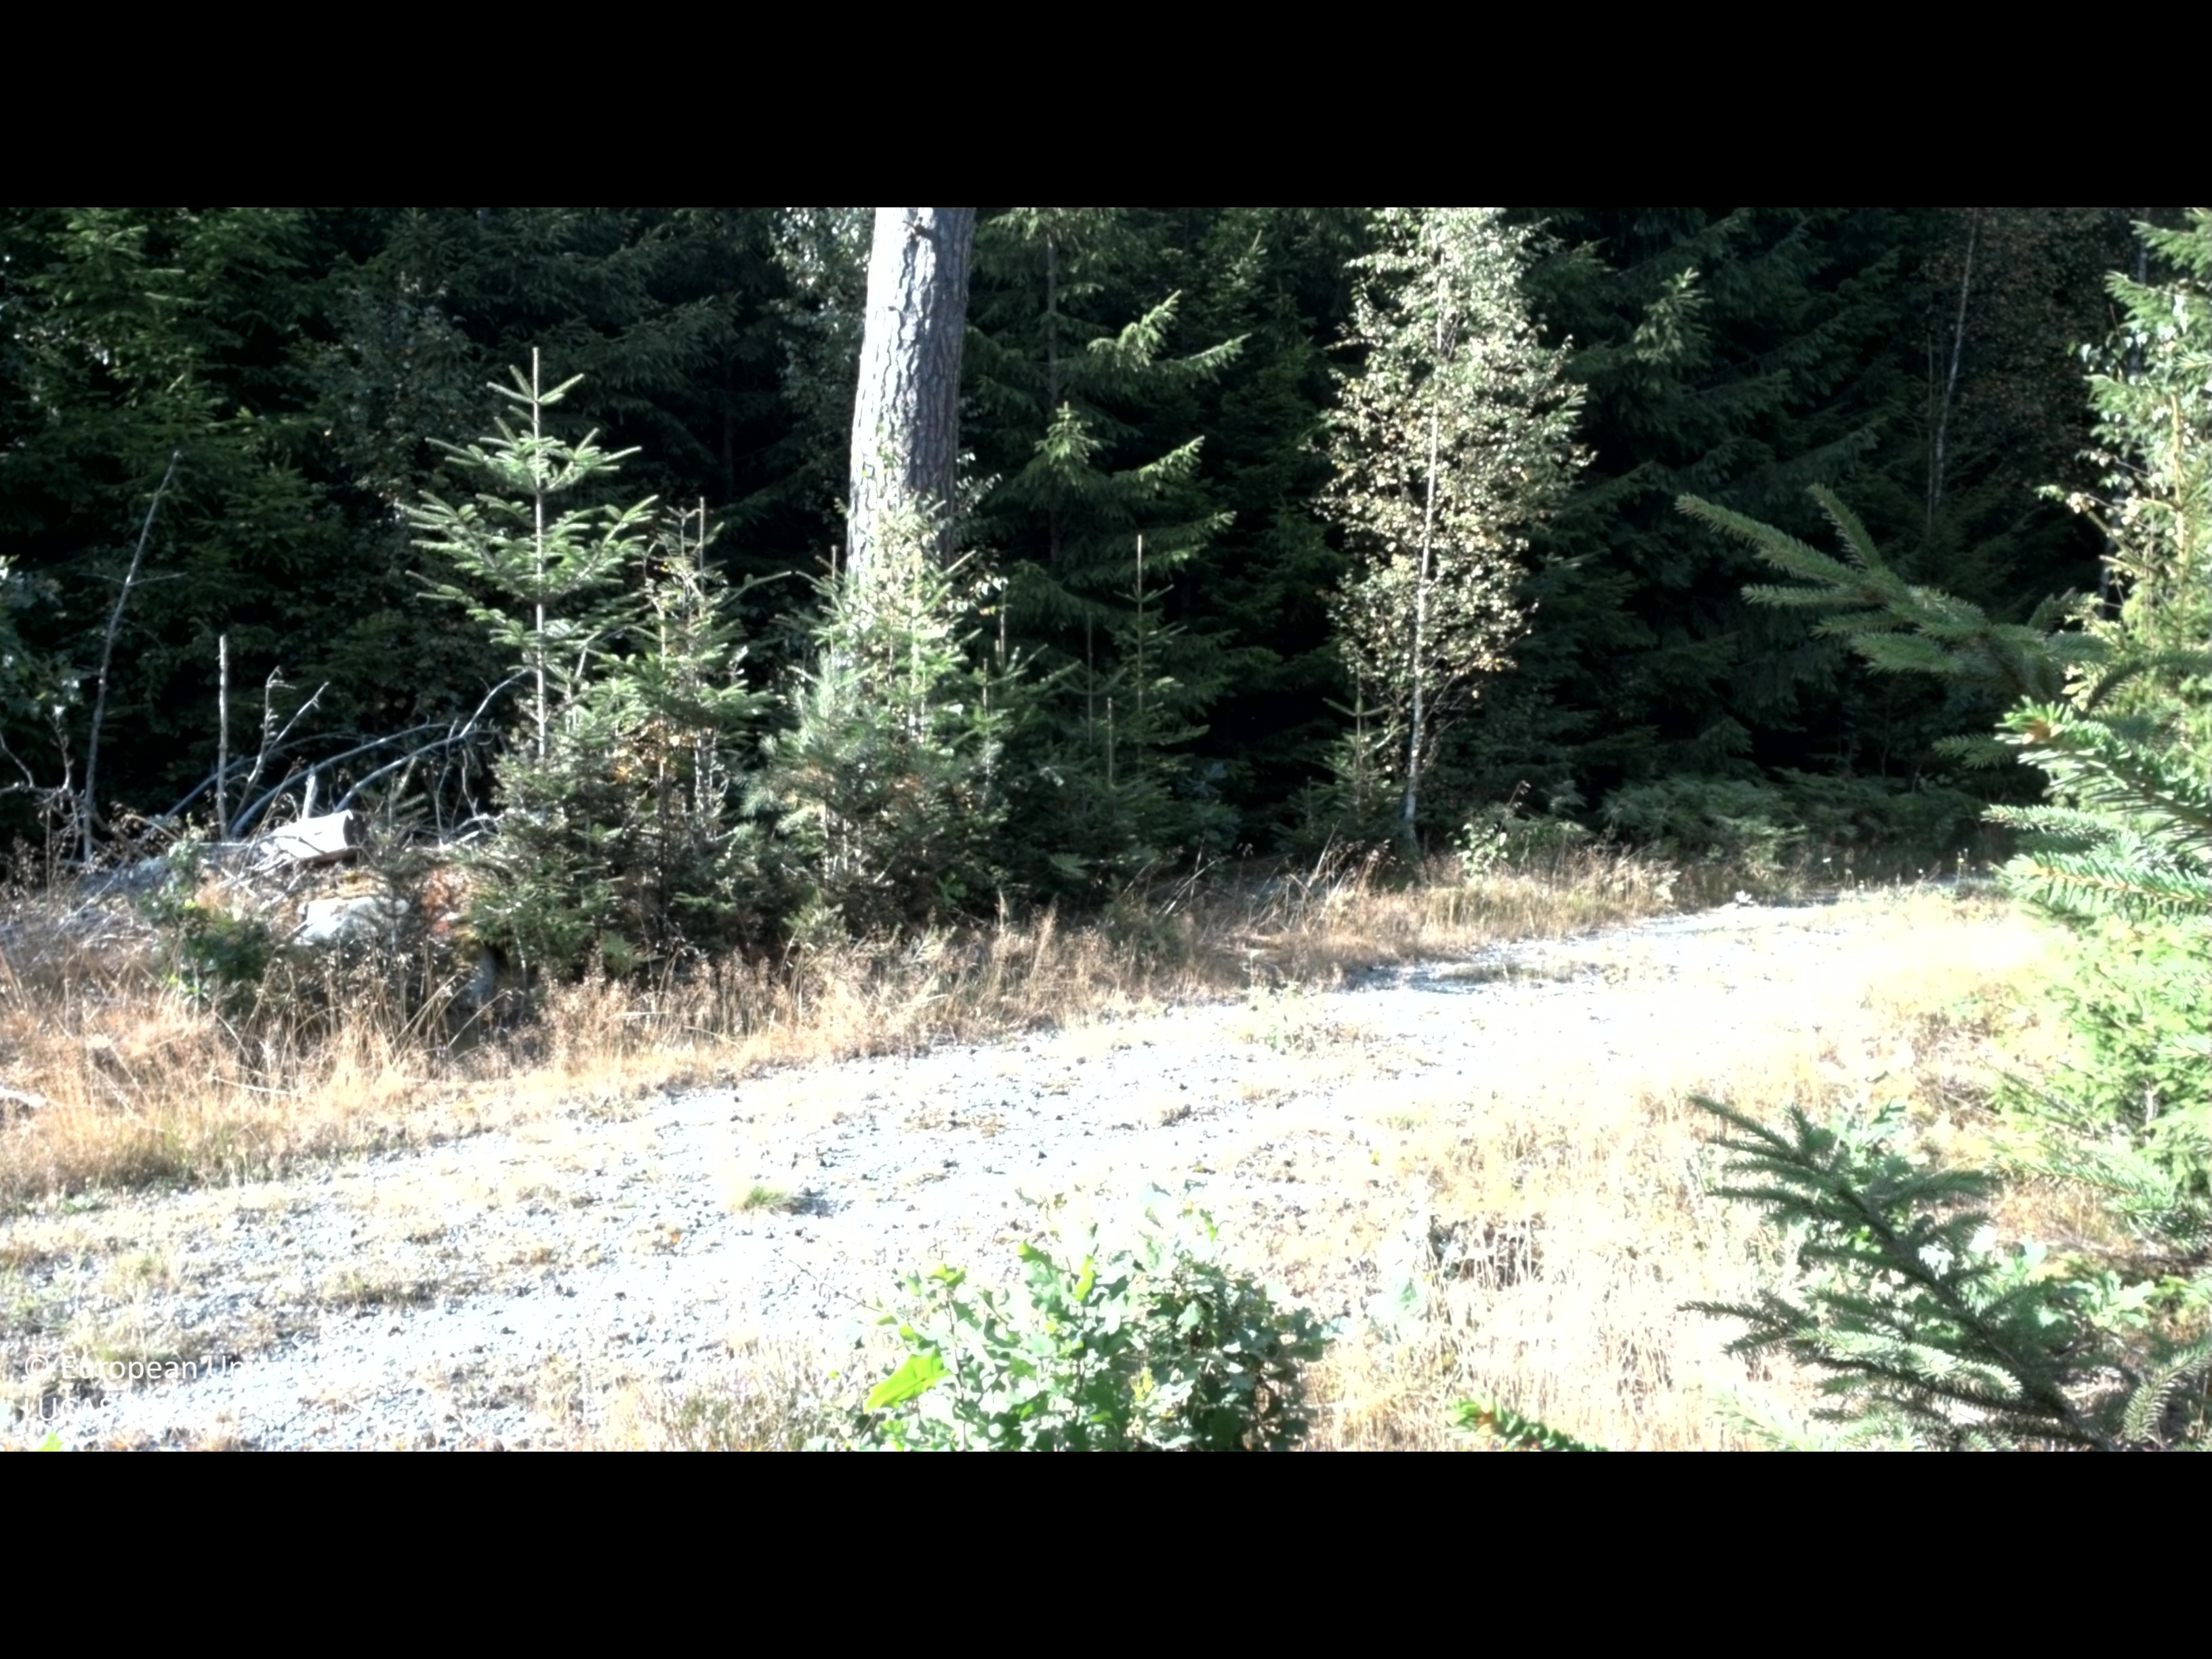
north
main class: Woodland
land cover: Spruce dominated mixed woodland
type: boreal forest
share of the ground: 50 - 75 %
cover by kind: broadleaved forest trees 40 %, herbaceous plants 30 %, coniferous forest trees 20 %, shrubs 10 %
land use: Forestry
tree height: < 5 m
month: August
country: SE
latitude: 57.0654
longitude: 13.8718
